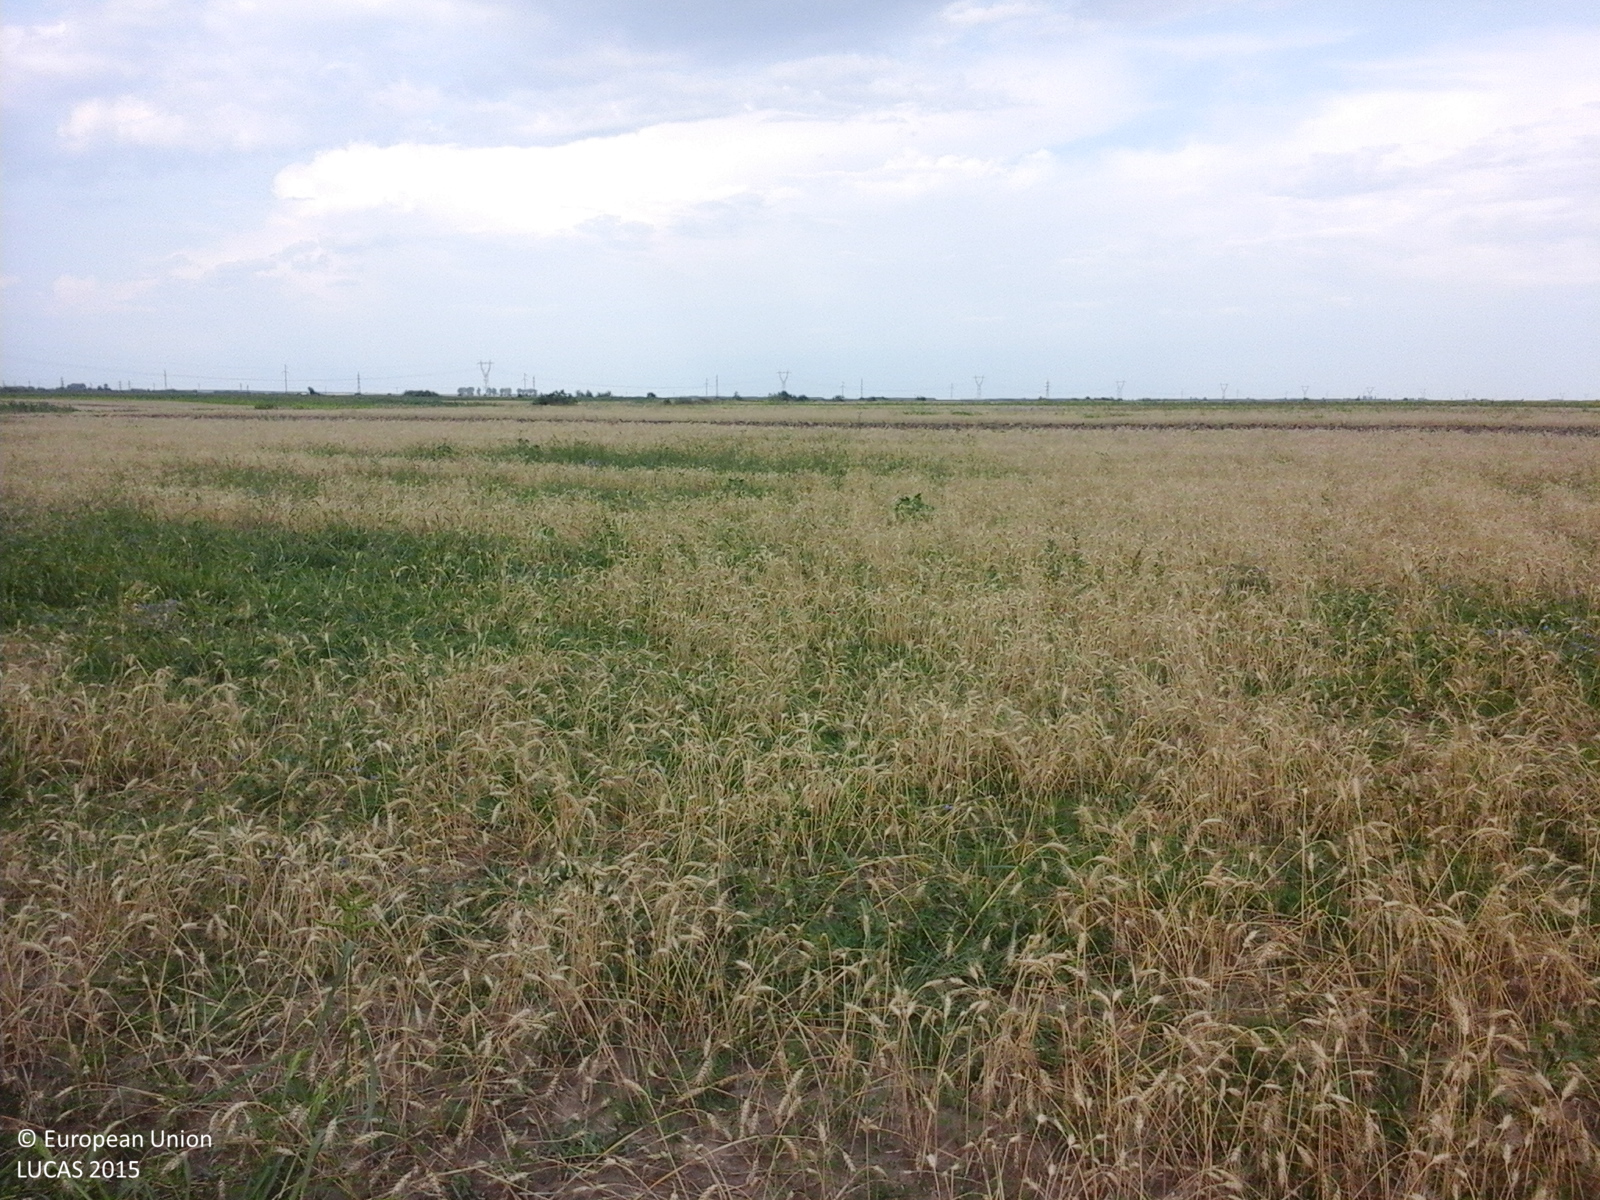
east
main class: Cropland
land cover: Common wheat
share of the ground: > 75 %
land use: Agriculture (excluding fallow land and kitchen gardens)
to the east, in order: Common wheat; Other bare soil; Common wheat; Grassland without tree/shrub cover; Common wheat; Other bare soil; Sunflower; Common wheat
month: July
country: RO
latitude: 44.1358
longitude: 24.0718
